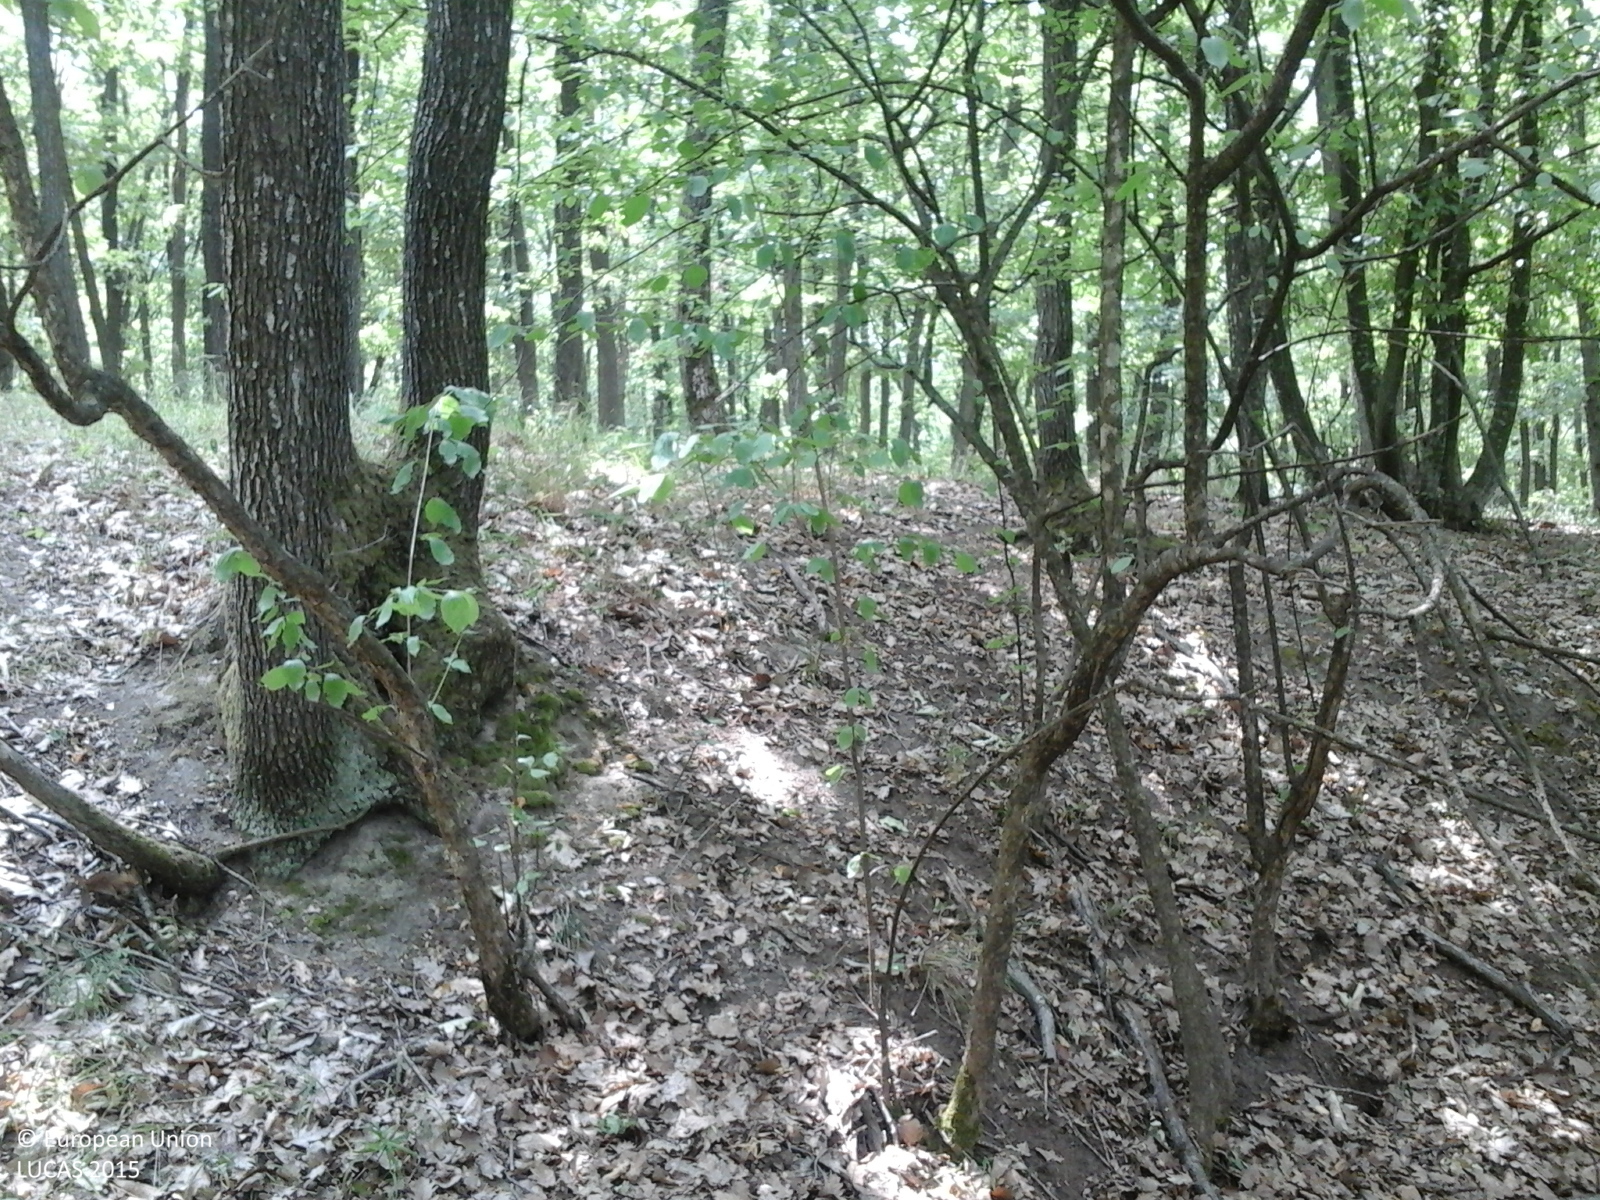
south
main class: Woodland
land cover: Broadleaved woodland
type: beech forest
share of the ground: > 75 %
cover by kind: broadleaved forest trees 100 %
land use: Forestry
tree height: > 5 m
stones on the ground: < 10 %
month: June
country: RO
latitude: 47.6917
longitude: 26.9302
